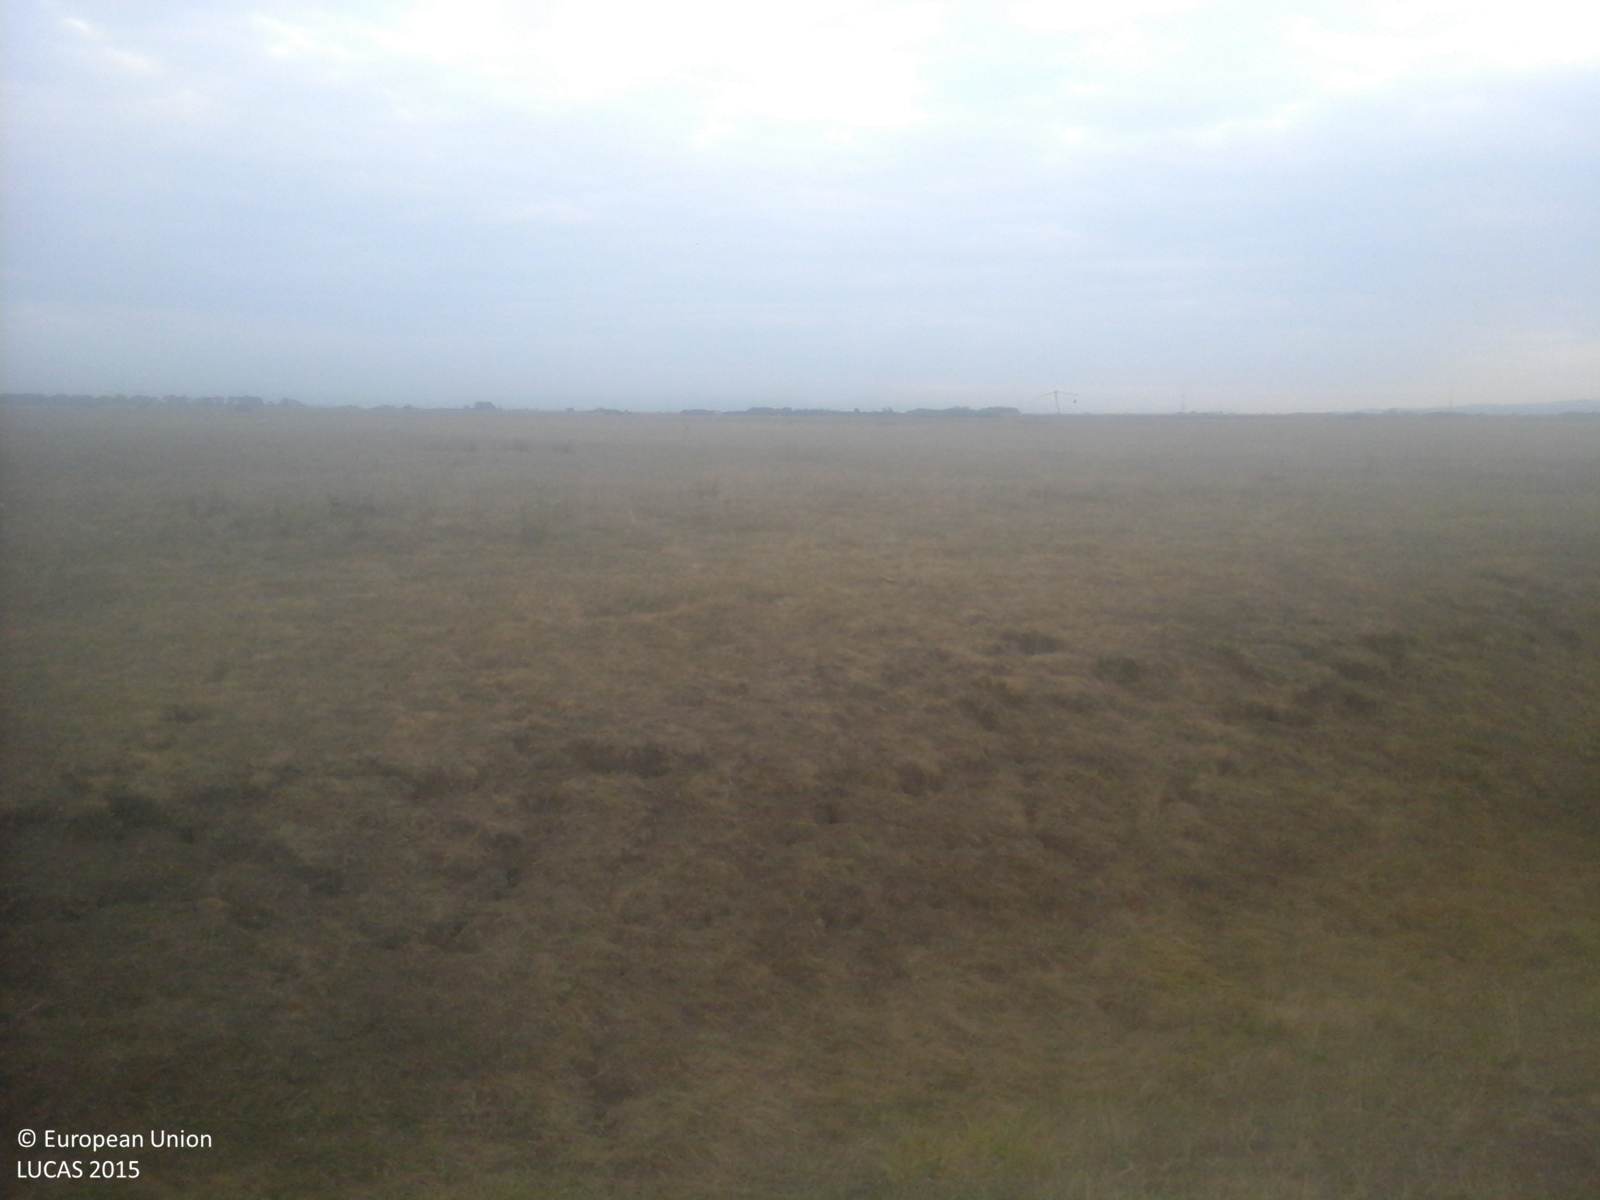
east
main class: Grassland
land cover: Grassland without tree/shrub cover
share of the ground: > 75 %
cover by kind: herbaceous plants 100 %
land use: Agriculture (excluding fallow land and kitchen gardens)
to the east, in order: Grassland without tree/shrub cover; Ditches and canals; Spontaneously vegetated surfaces
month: September
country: RO
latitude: 47.7531
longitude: 22.7479
